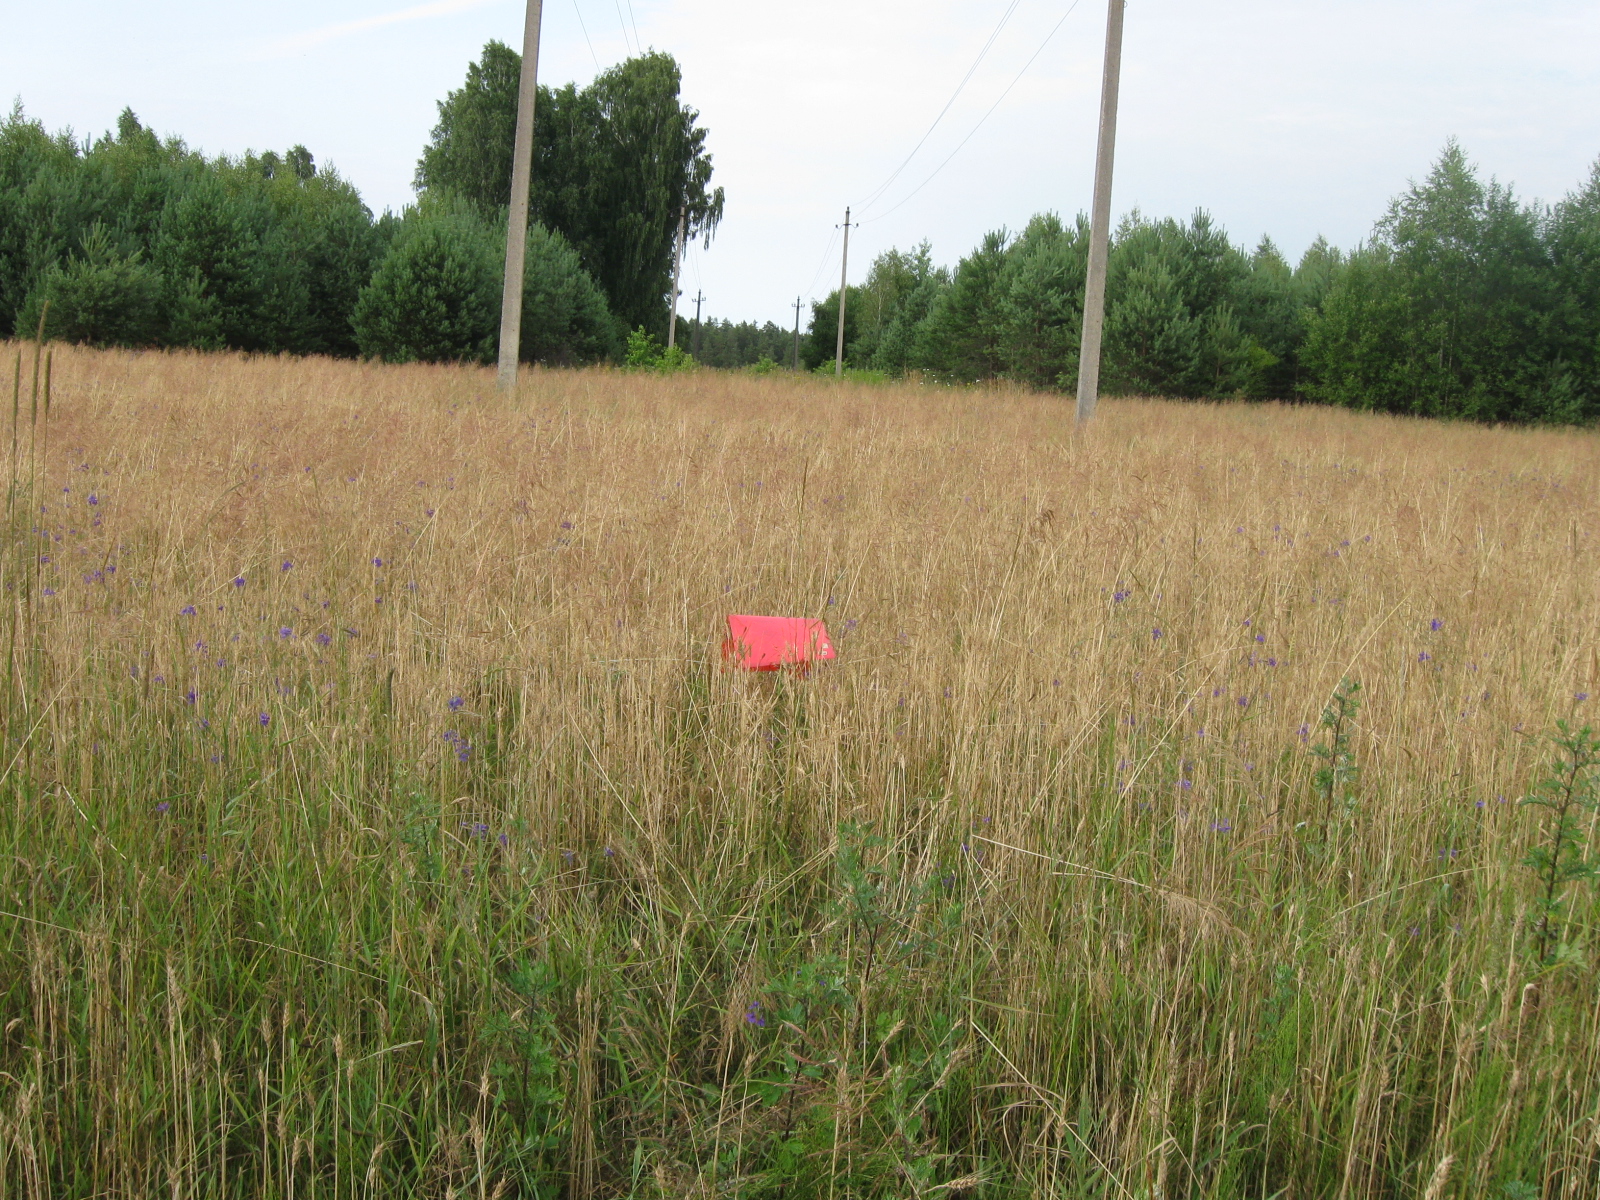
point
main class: Cropland
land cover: Durum wheat
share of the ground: > 75 %
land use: Agriculture (excluding fallow land and kitchen gardens)
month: July
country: LT
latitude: 54.6130
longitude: 23.9807
